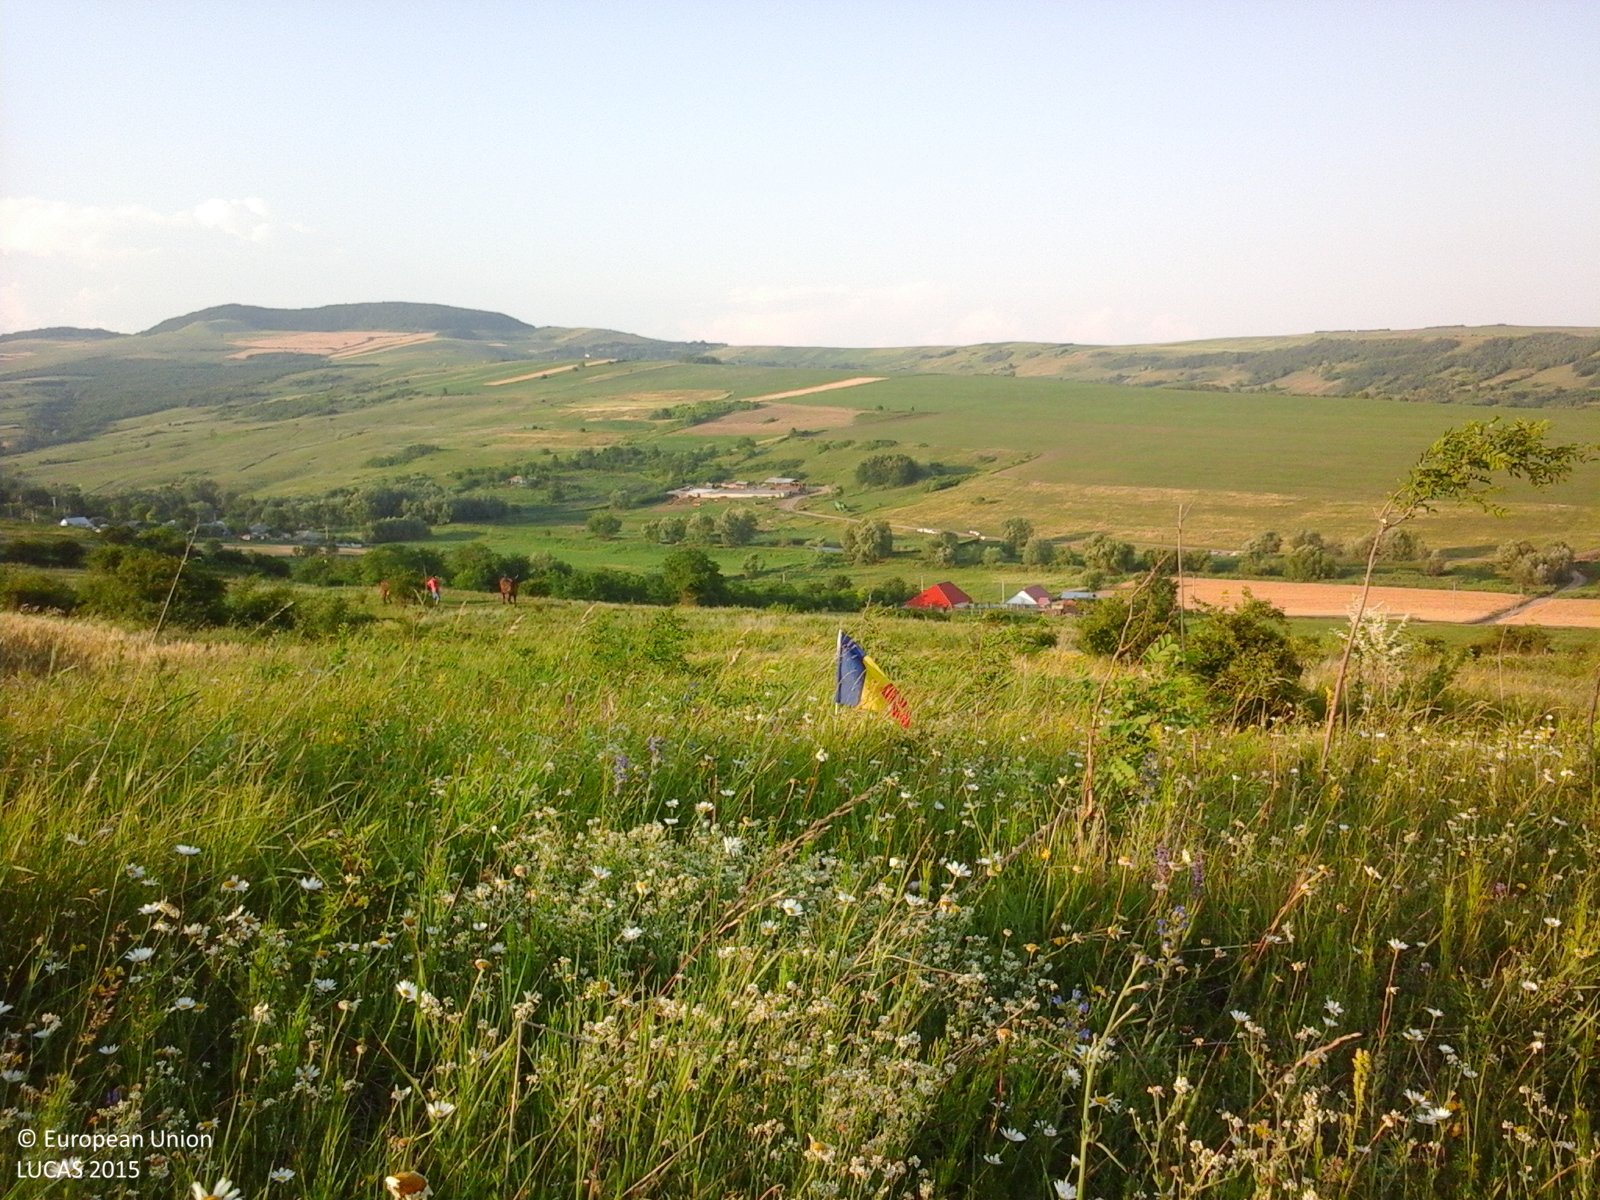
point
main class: Grassland
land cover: Grassland with sparse tree/shrub cover
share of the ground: > 75 %
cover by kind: herbaceous plants 90 %, broadleaved forest trees 5 %, shrubs 5 %
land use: Agriculture (excluding fallow land and kitchen gardens)
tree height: < 5 m
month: June
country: RO
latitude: 46.6690
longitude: 27.4556
